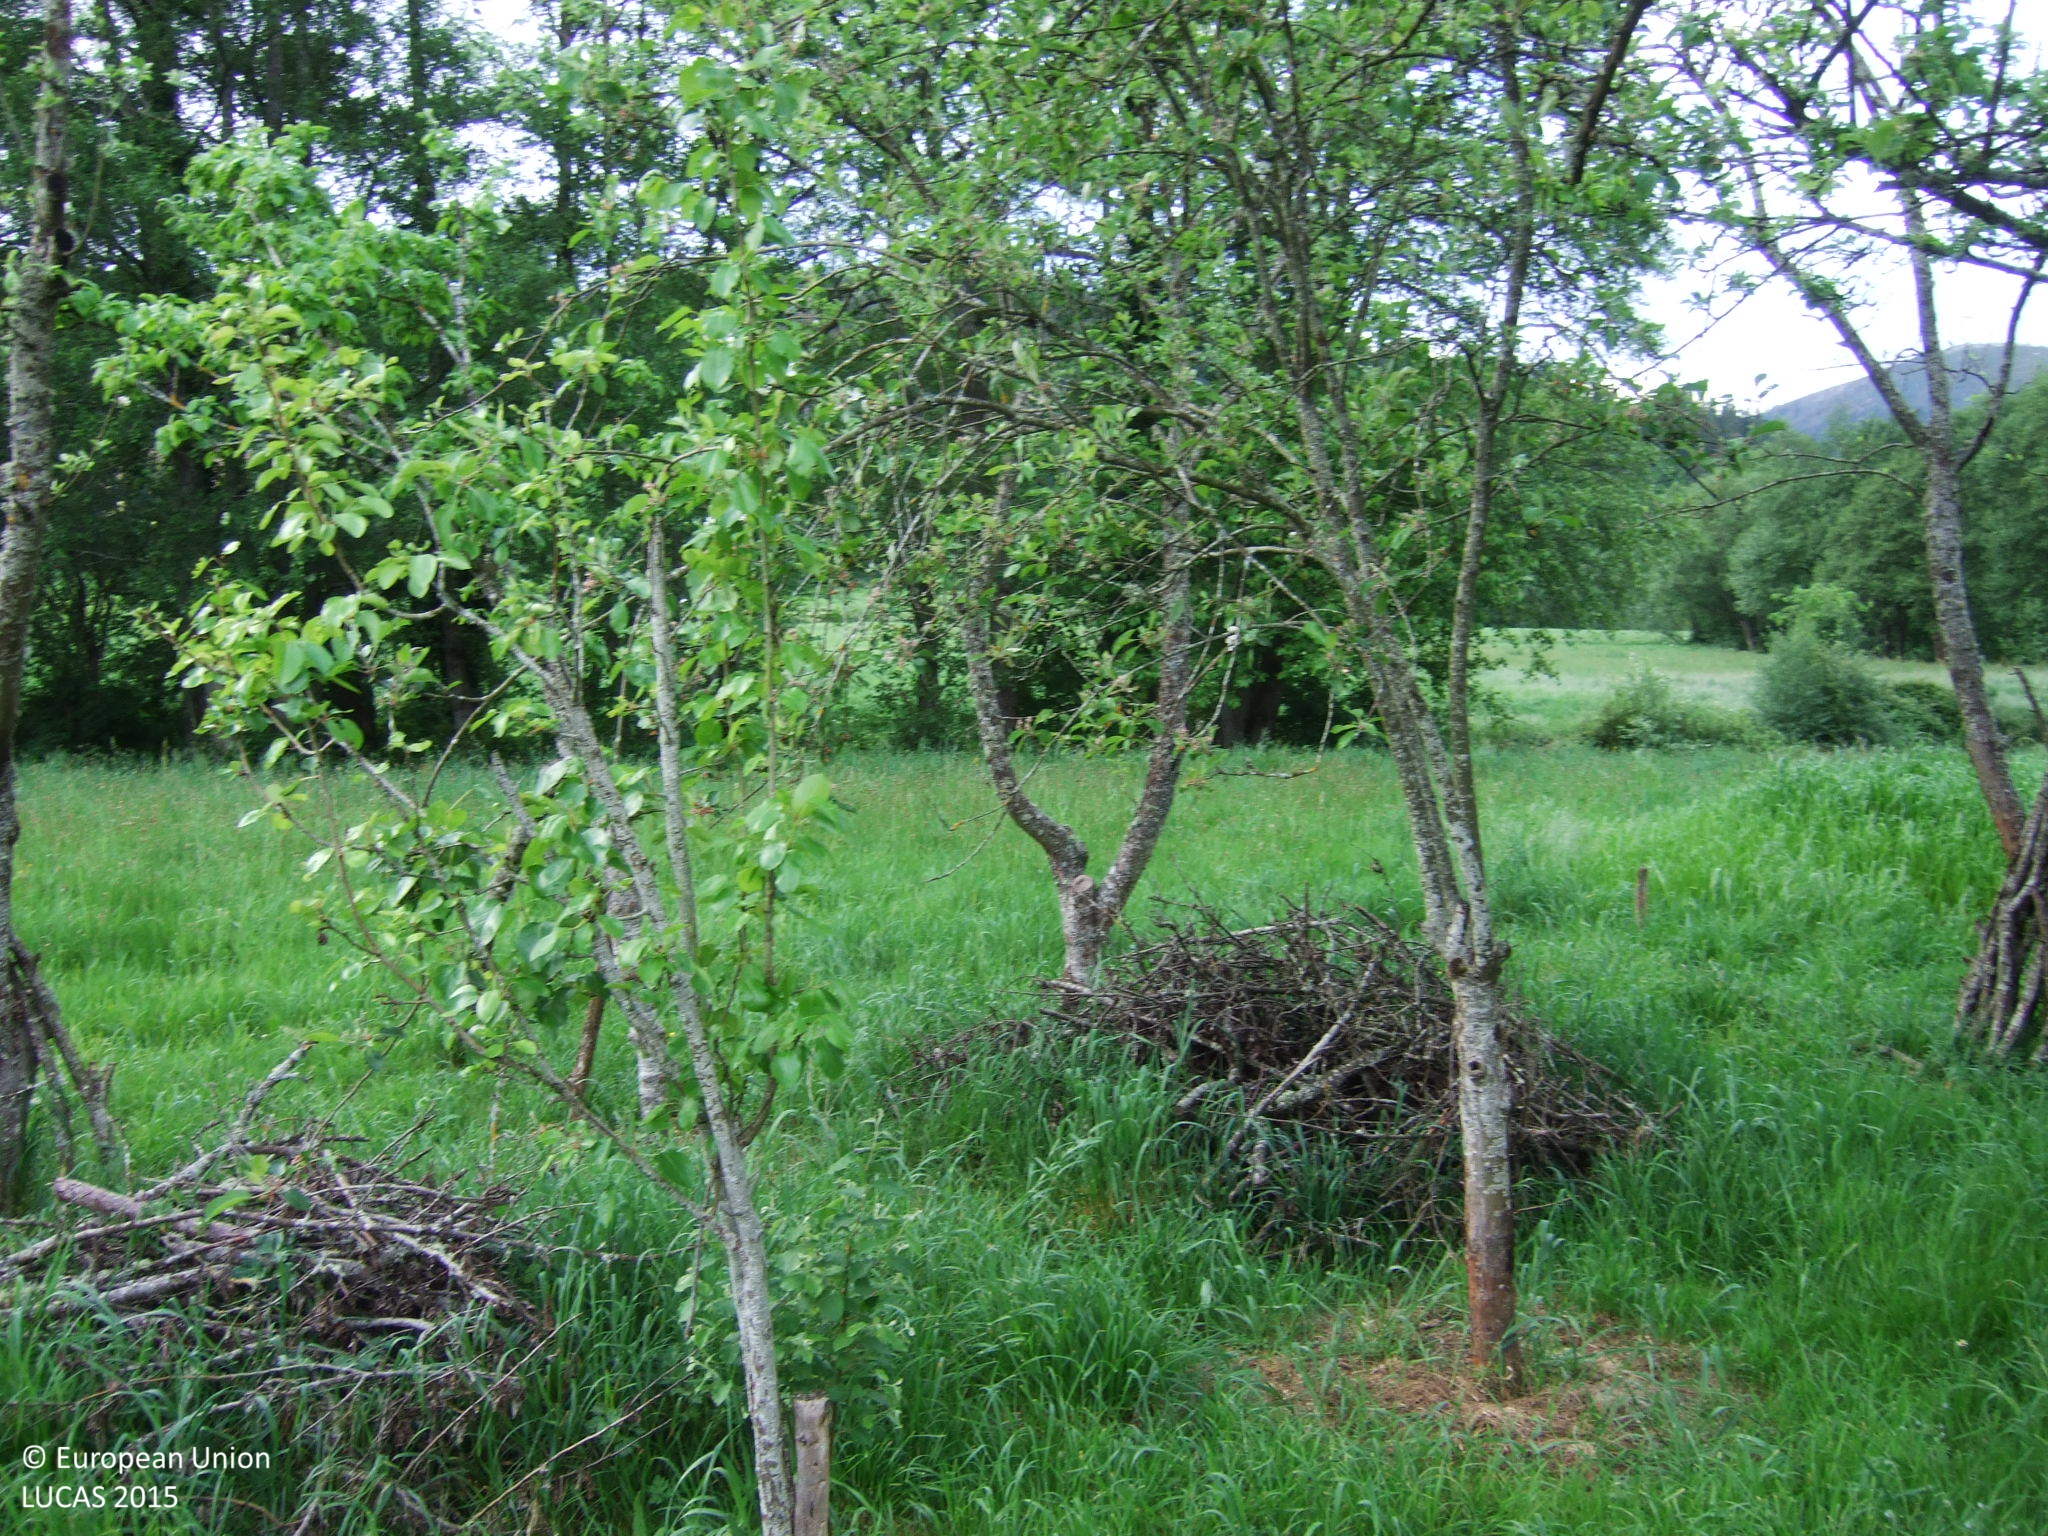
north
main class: Cropland
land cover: Other fresh vegetables
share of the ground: 50 - 75 %
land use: Agriculture (excluding fallow land and kitchen gardens)
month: May
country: ES
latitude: 43.1587
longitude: -7.2010
